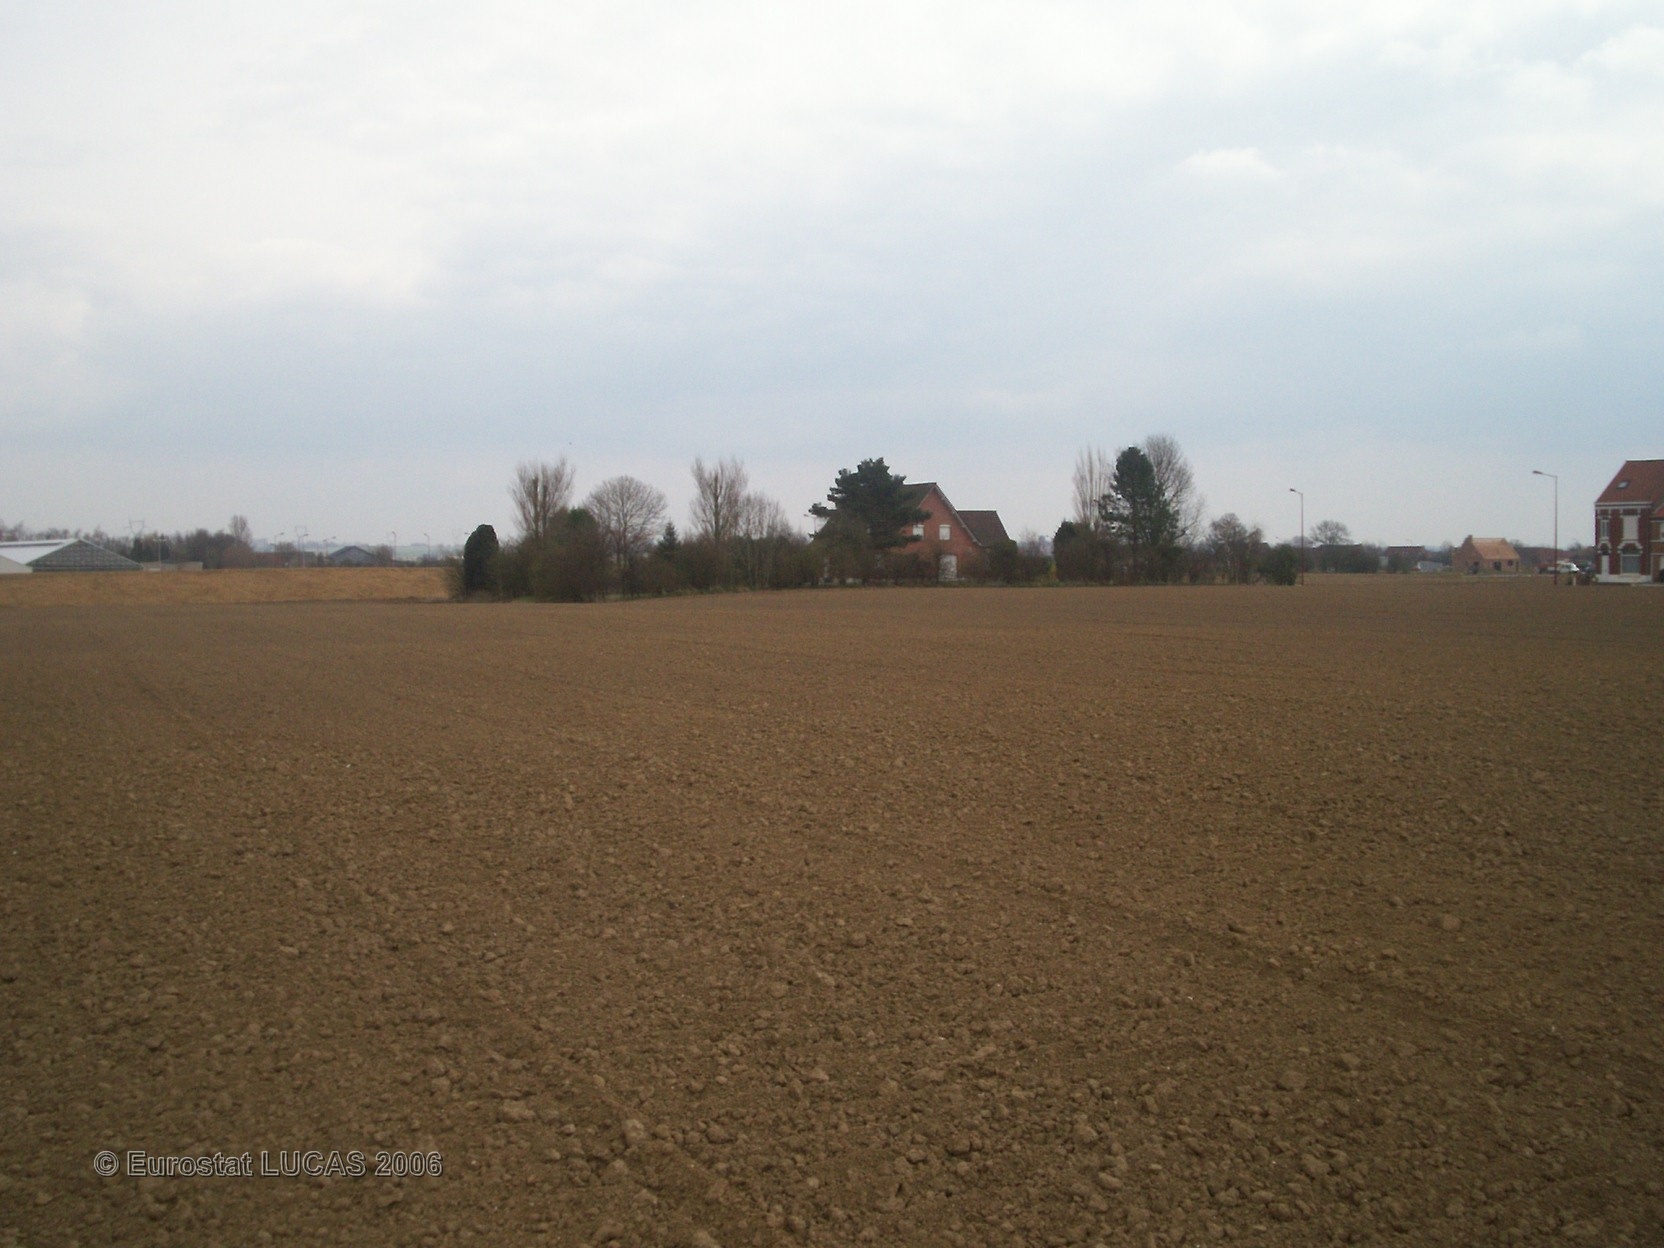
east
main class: Cropland
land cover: Maize
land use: Agriculture (excluding fallow land and kitchen gardens)
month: May
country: FR
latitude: 50.7349
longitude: 2.5489
